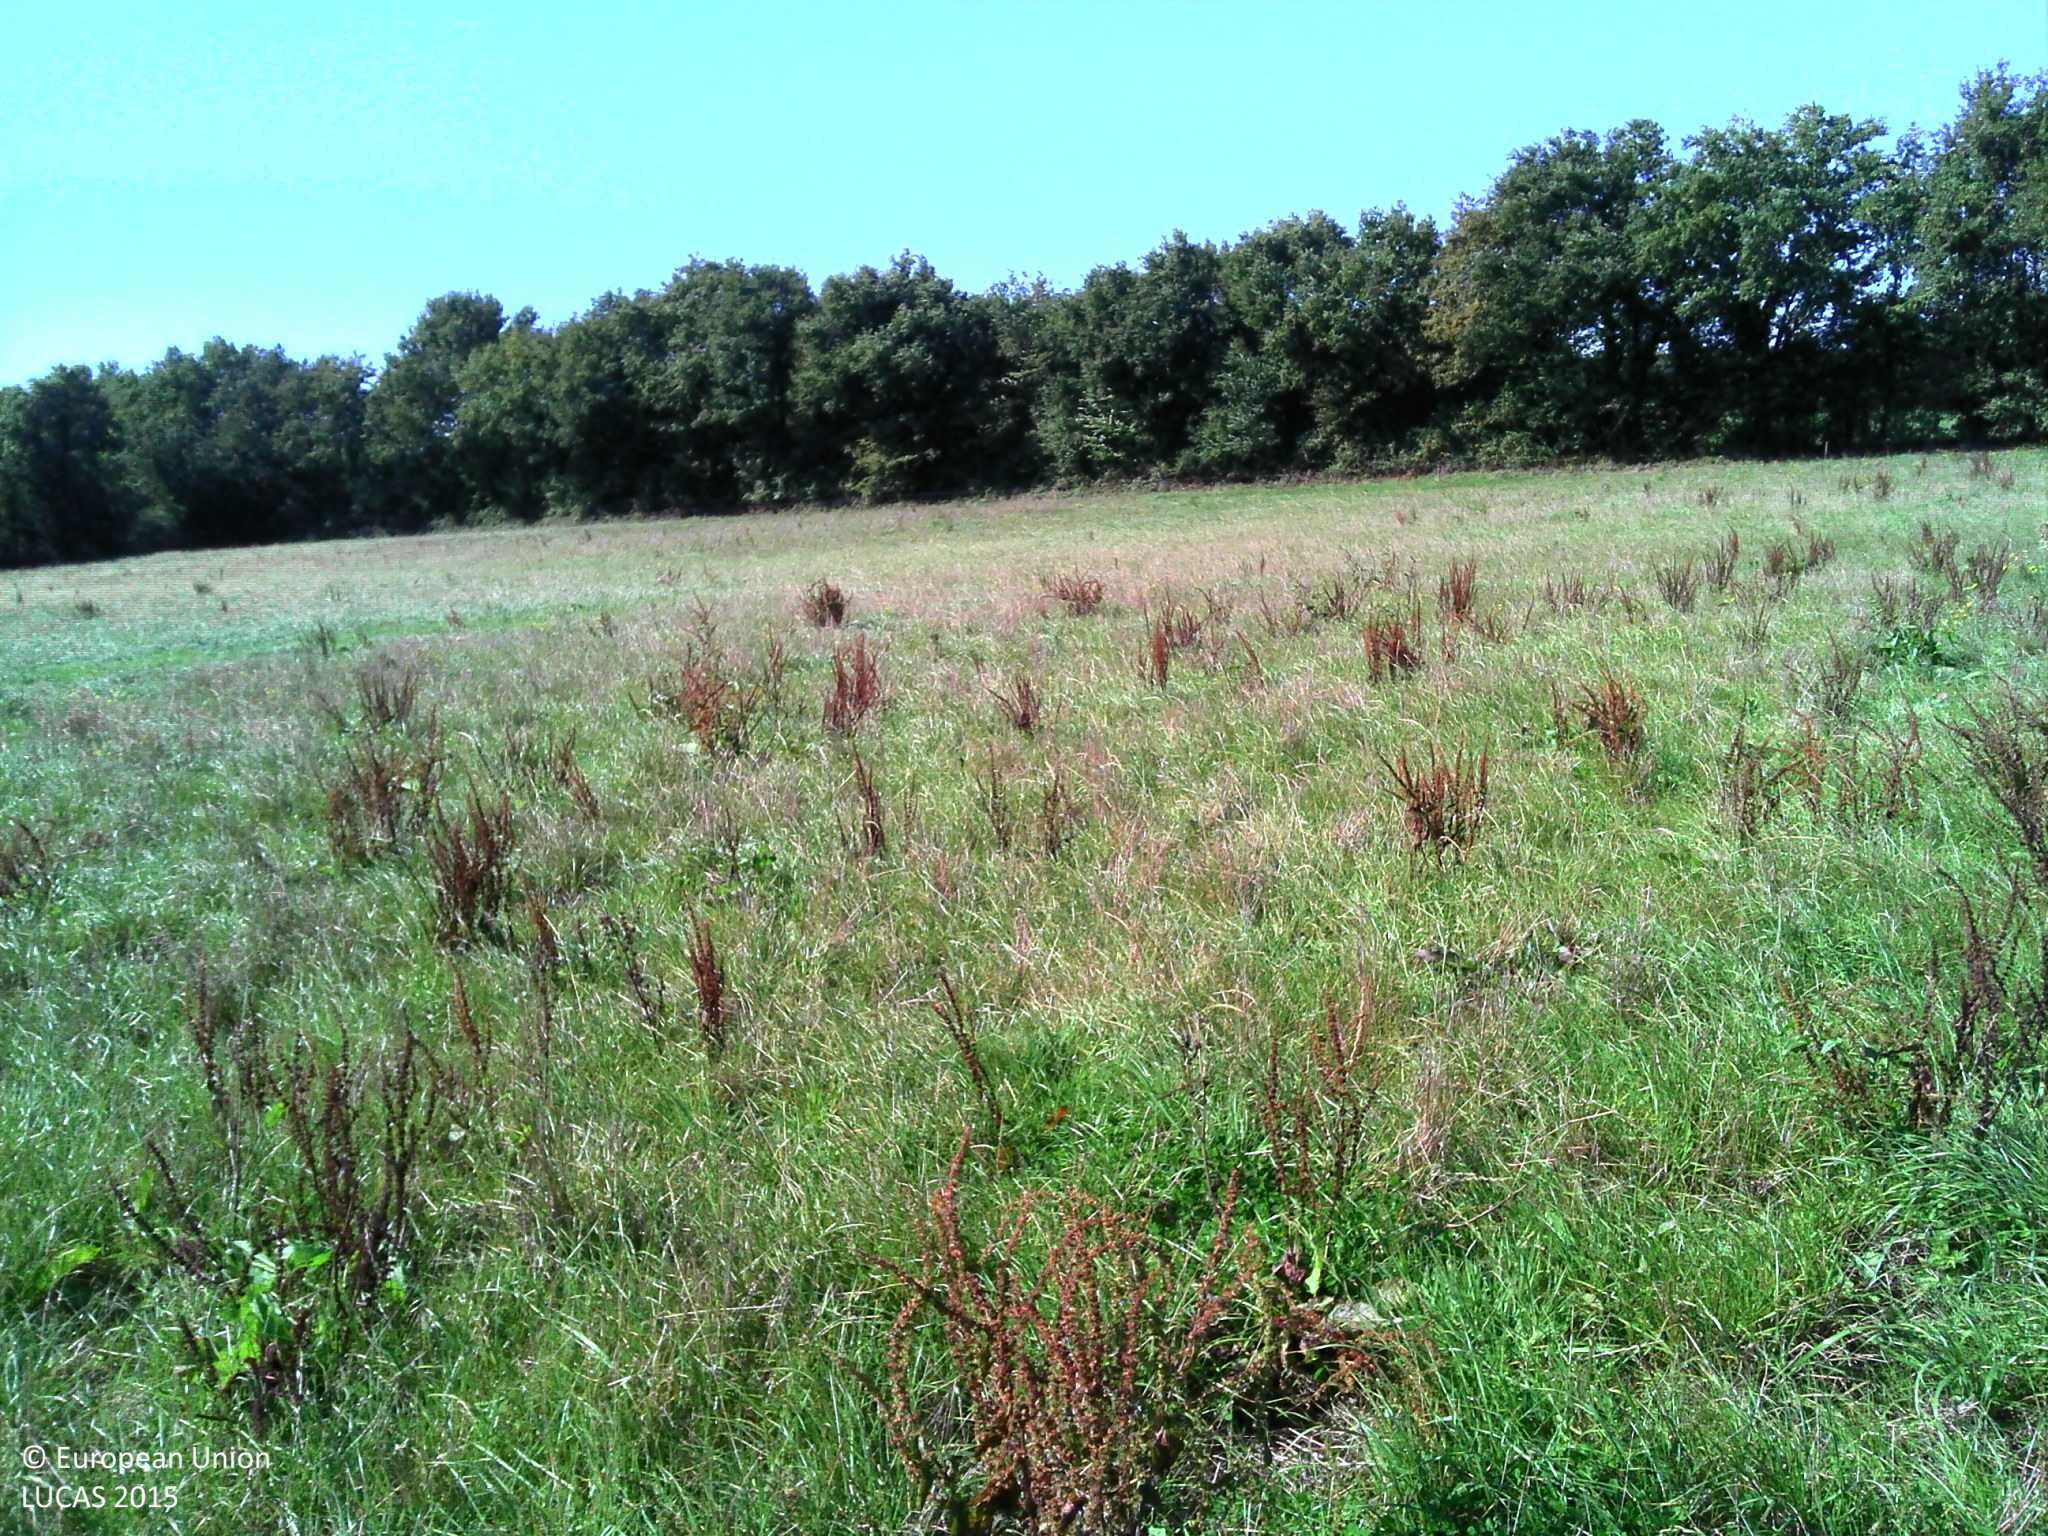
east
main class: Grassland
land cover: Grassland without tree/shrub cover
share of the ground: > 75 %
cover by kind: herbaceous plants 100 %
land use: Agriculture (excluding fallow land and kitchen gardens)
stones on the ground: < 10 %
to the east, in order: Grassland without tree/shrub cover; Fences; Broadleaved woodland; Tracks; Broadleaved woodland; Maize; Electric lines; Maize; Broadleaved woodland; Ditches and canals
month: September
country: FR
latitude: 46.6044
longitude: -1.3026
